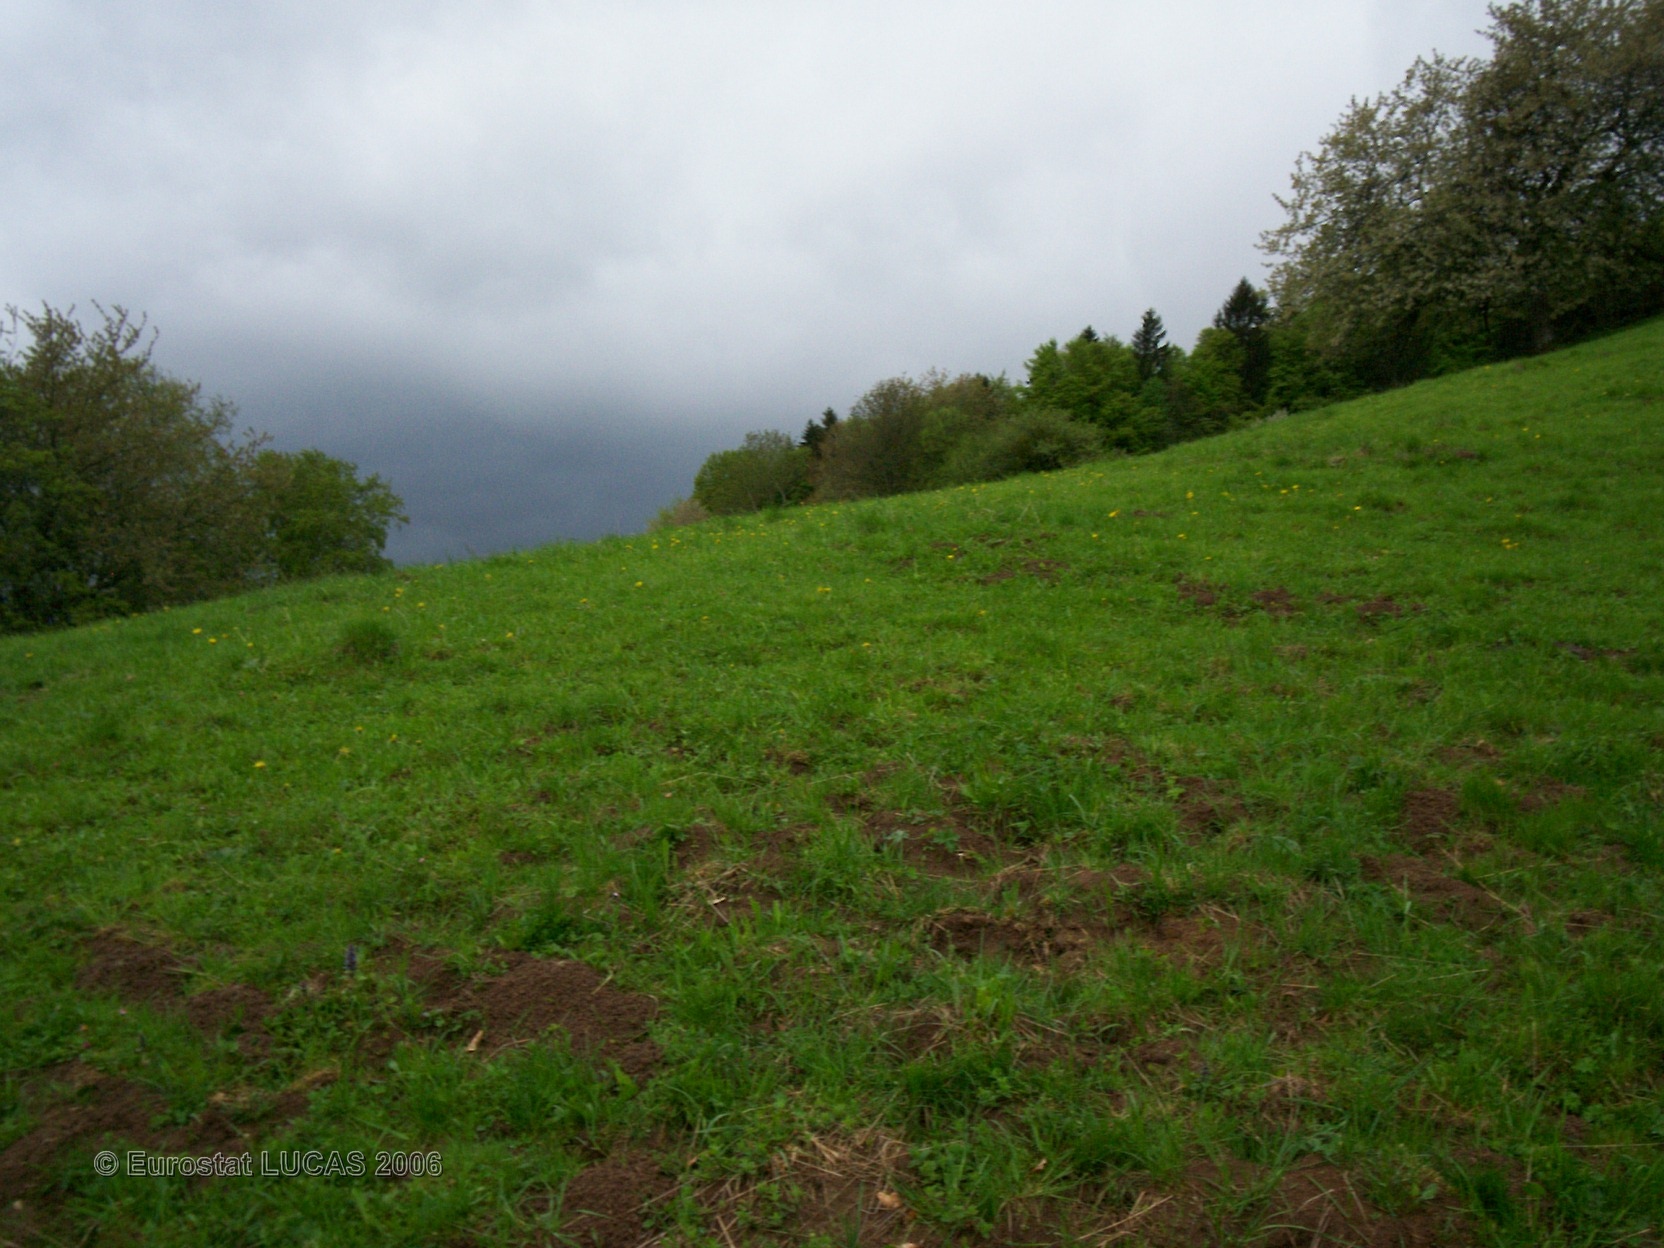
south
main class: Grassland
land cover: Grassland without tree/shrub cover
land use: Agriculture (excluding fallow land and kitchen gardens)
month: May
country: FR
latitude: 45.7944
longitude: 6.1318
